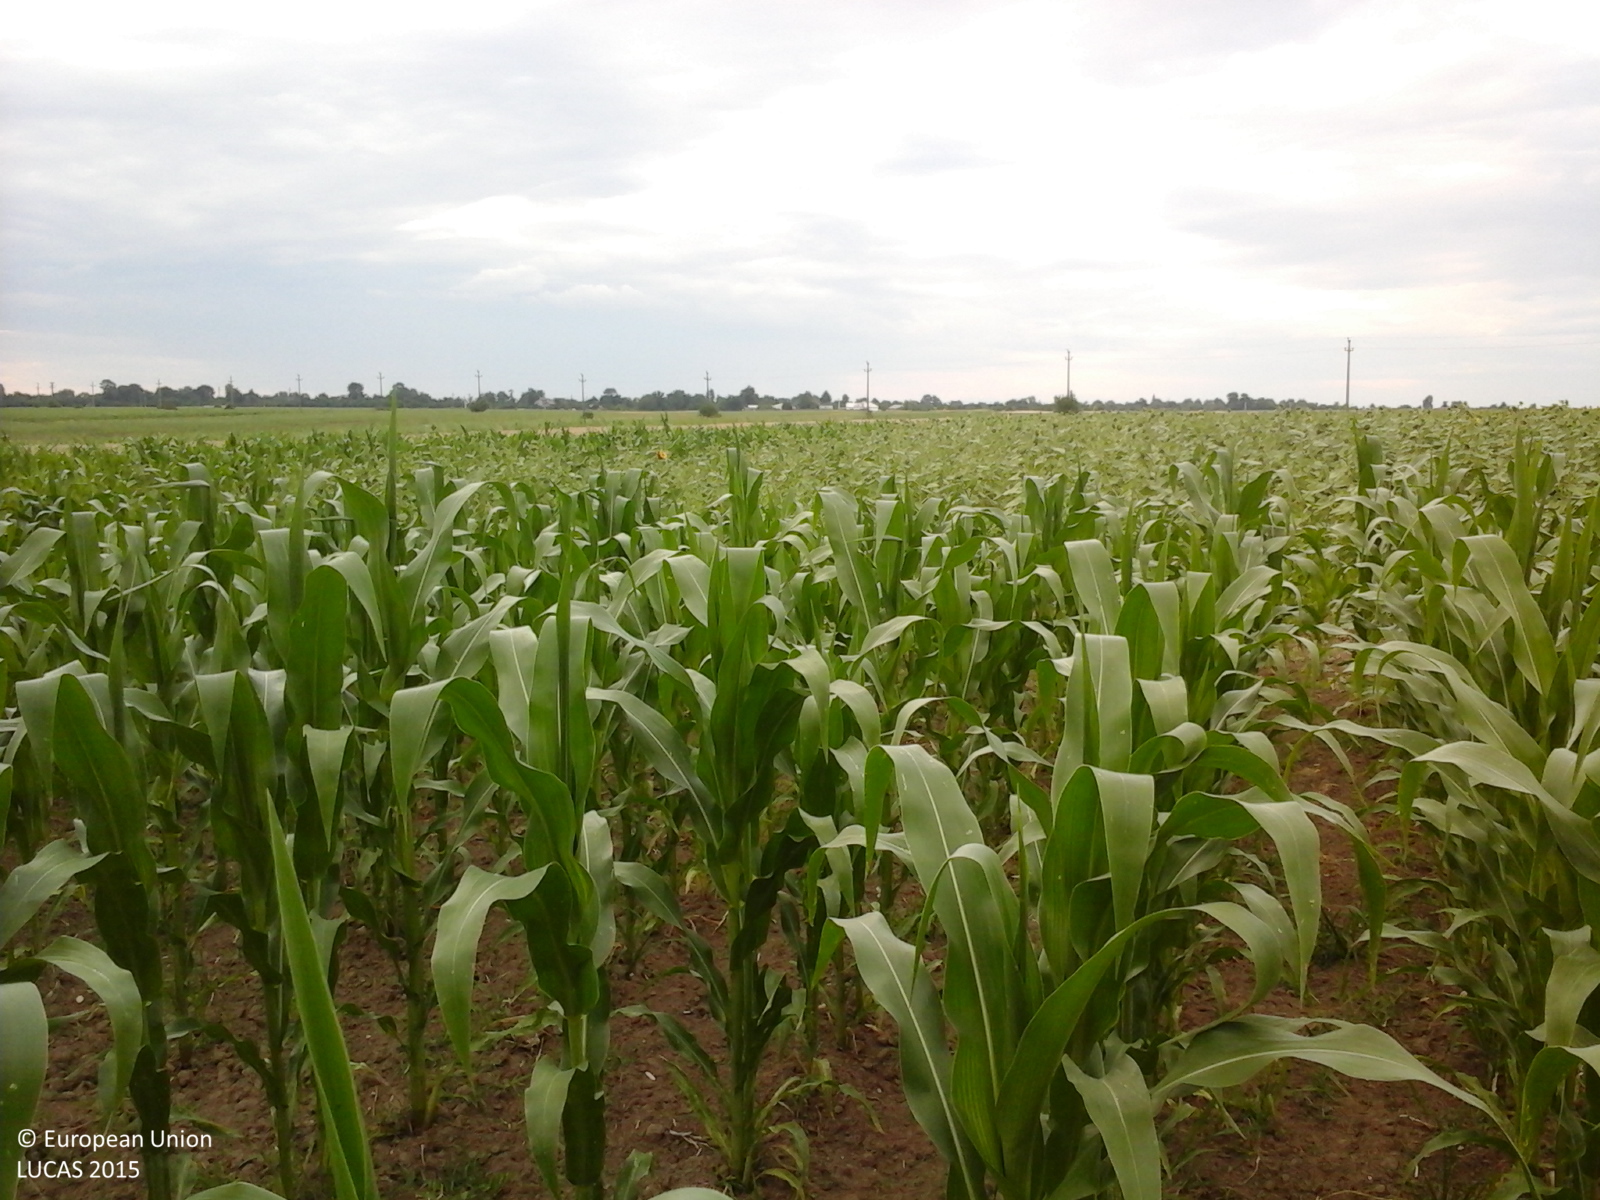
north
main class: Cropland
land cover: Maize
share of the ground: > 75 %
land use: Agriculture (excluding fallow land and kitchen gardens)
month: July
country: RO
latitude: 44.3303
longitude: 25.2719
